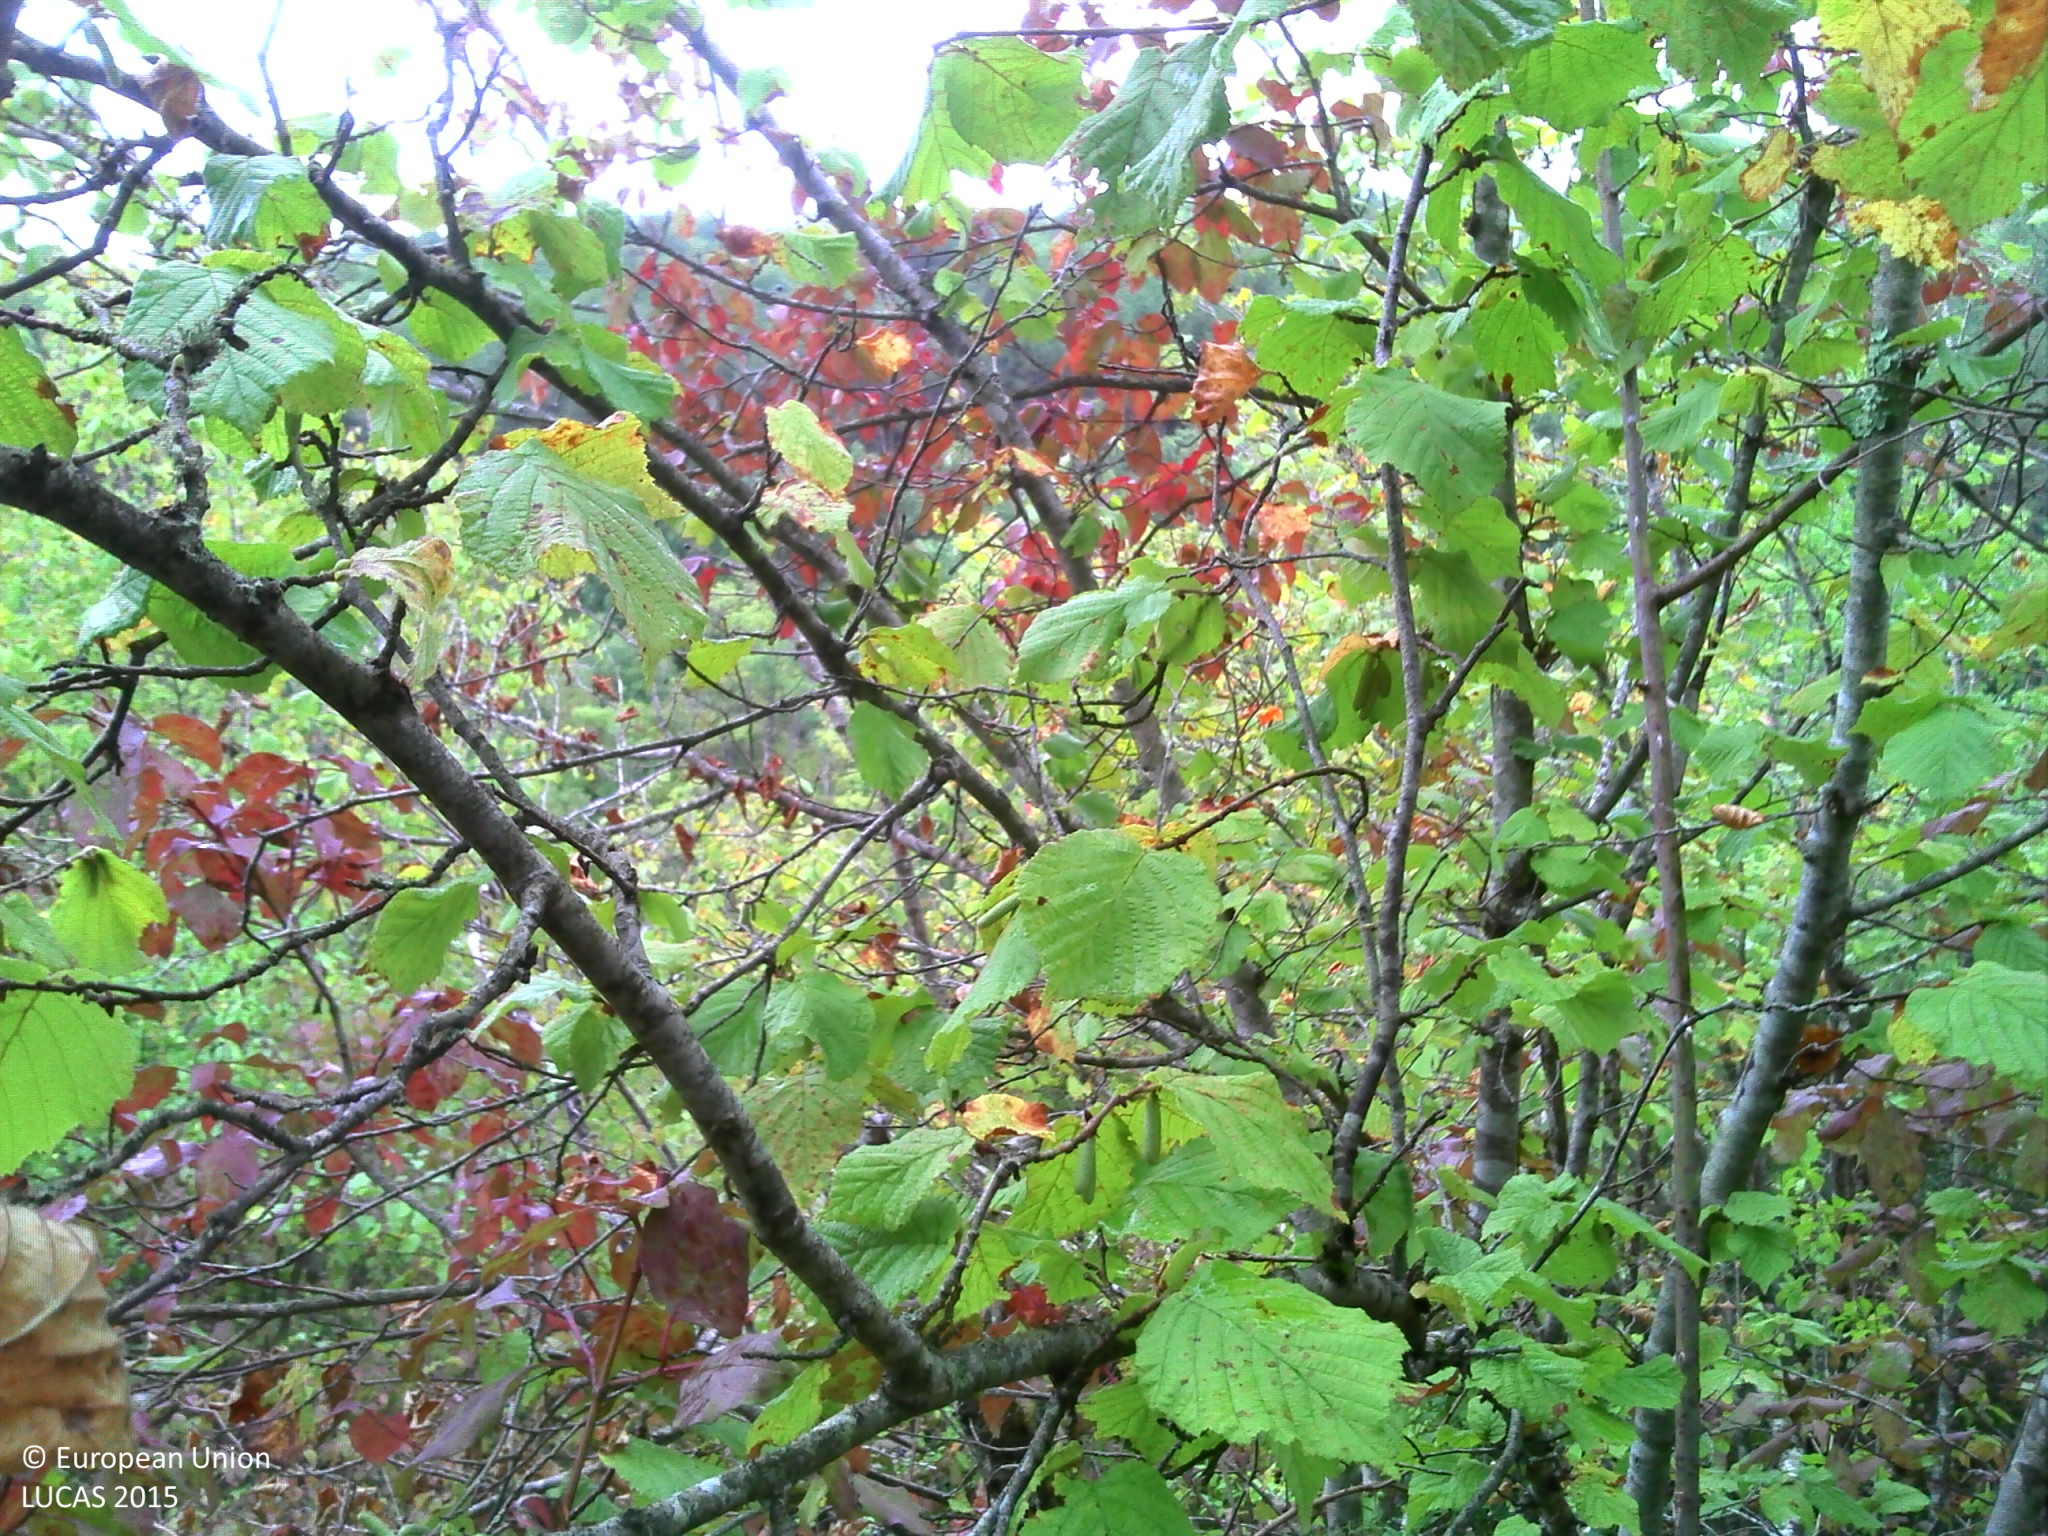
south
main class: Woodland
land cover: Broadleaved woodland
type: mesophytic deciduous forest
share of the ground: > 75 %
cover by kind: broadleaved forest trees 80 %, shrubs 10 %, herbaceous plants 10 %
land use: Semi-natural and natural areas not in use
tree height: < 5 m
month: September
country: FR
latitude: 47.0343
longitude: 4.7499
